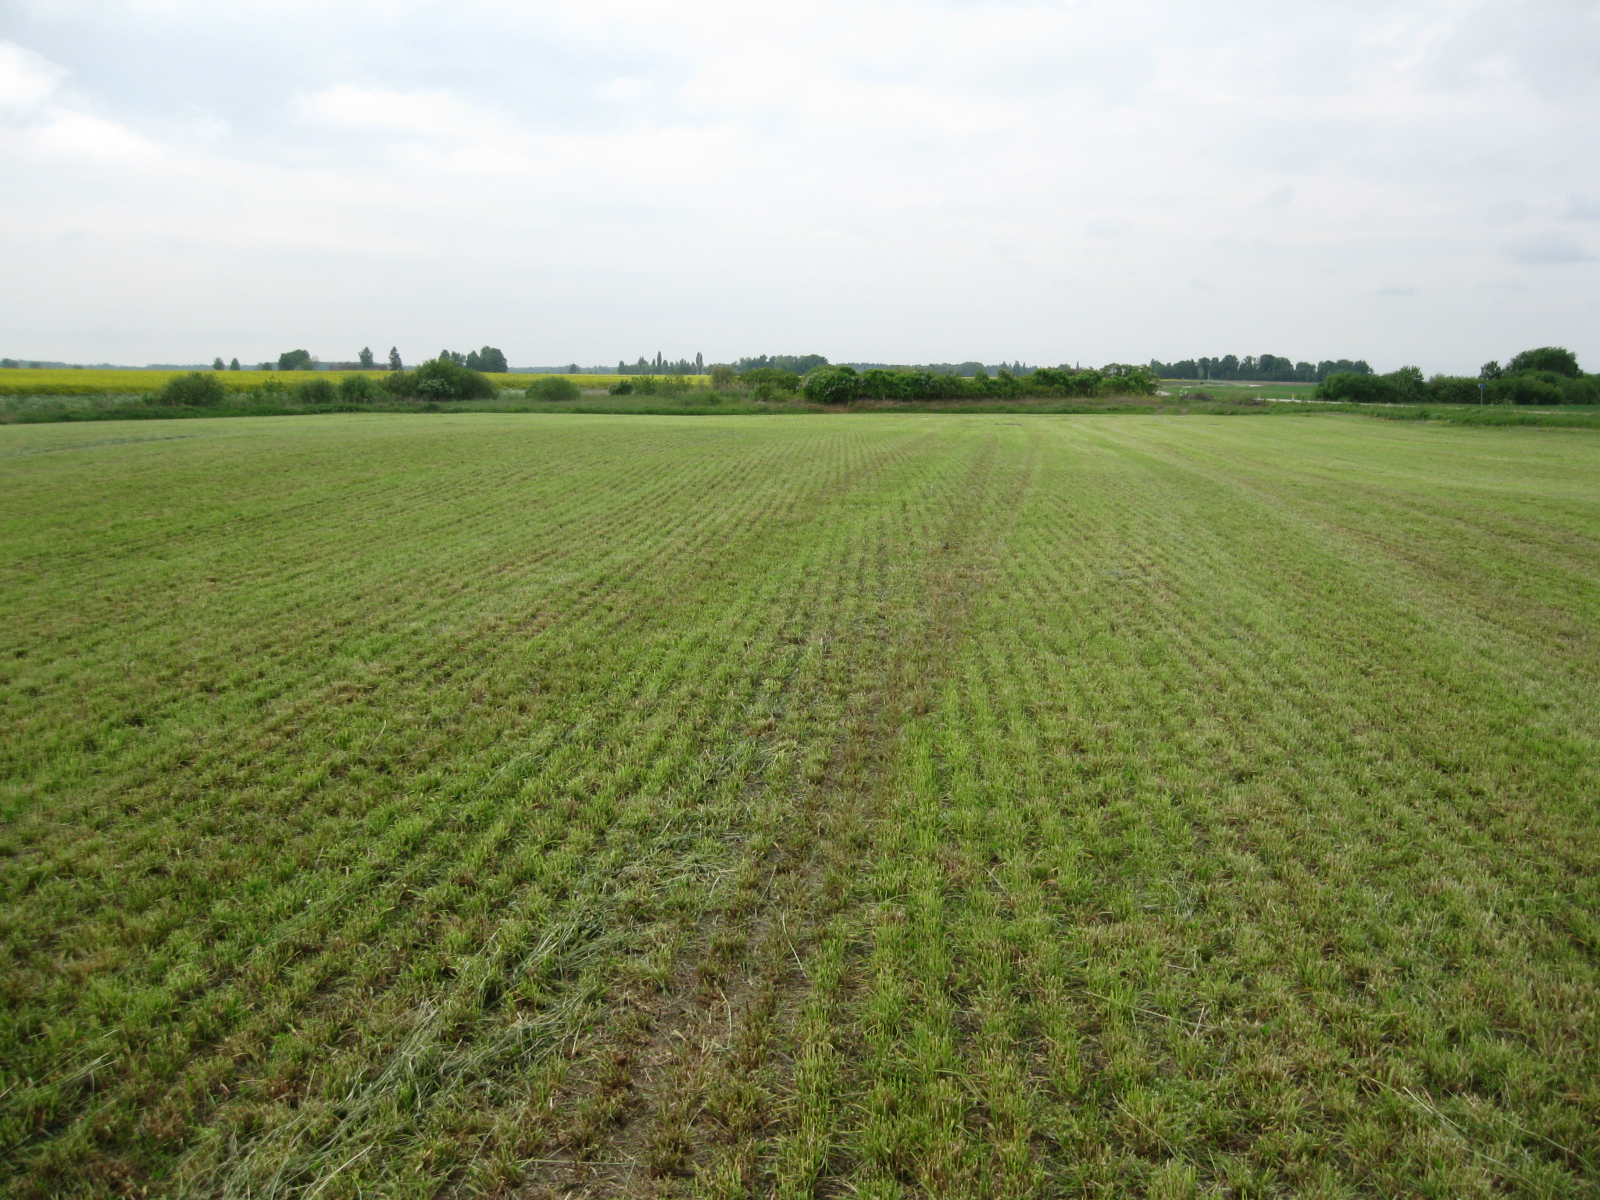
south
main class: Cropland
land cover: Temporary grasslands
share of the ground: > 75 %
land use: Agriculture (excluding fallow land and kitchen gardens)
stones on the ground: < 10 %
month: June
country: LT
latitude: 55.9485
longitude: 24.1341
